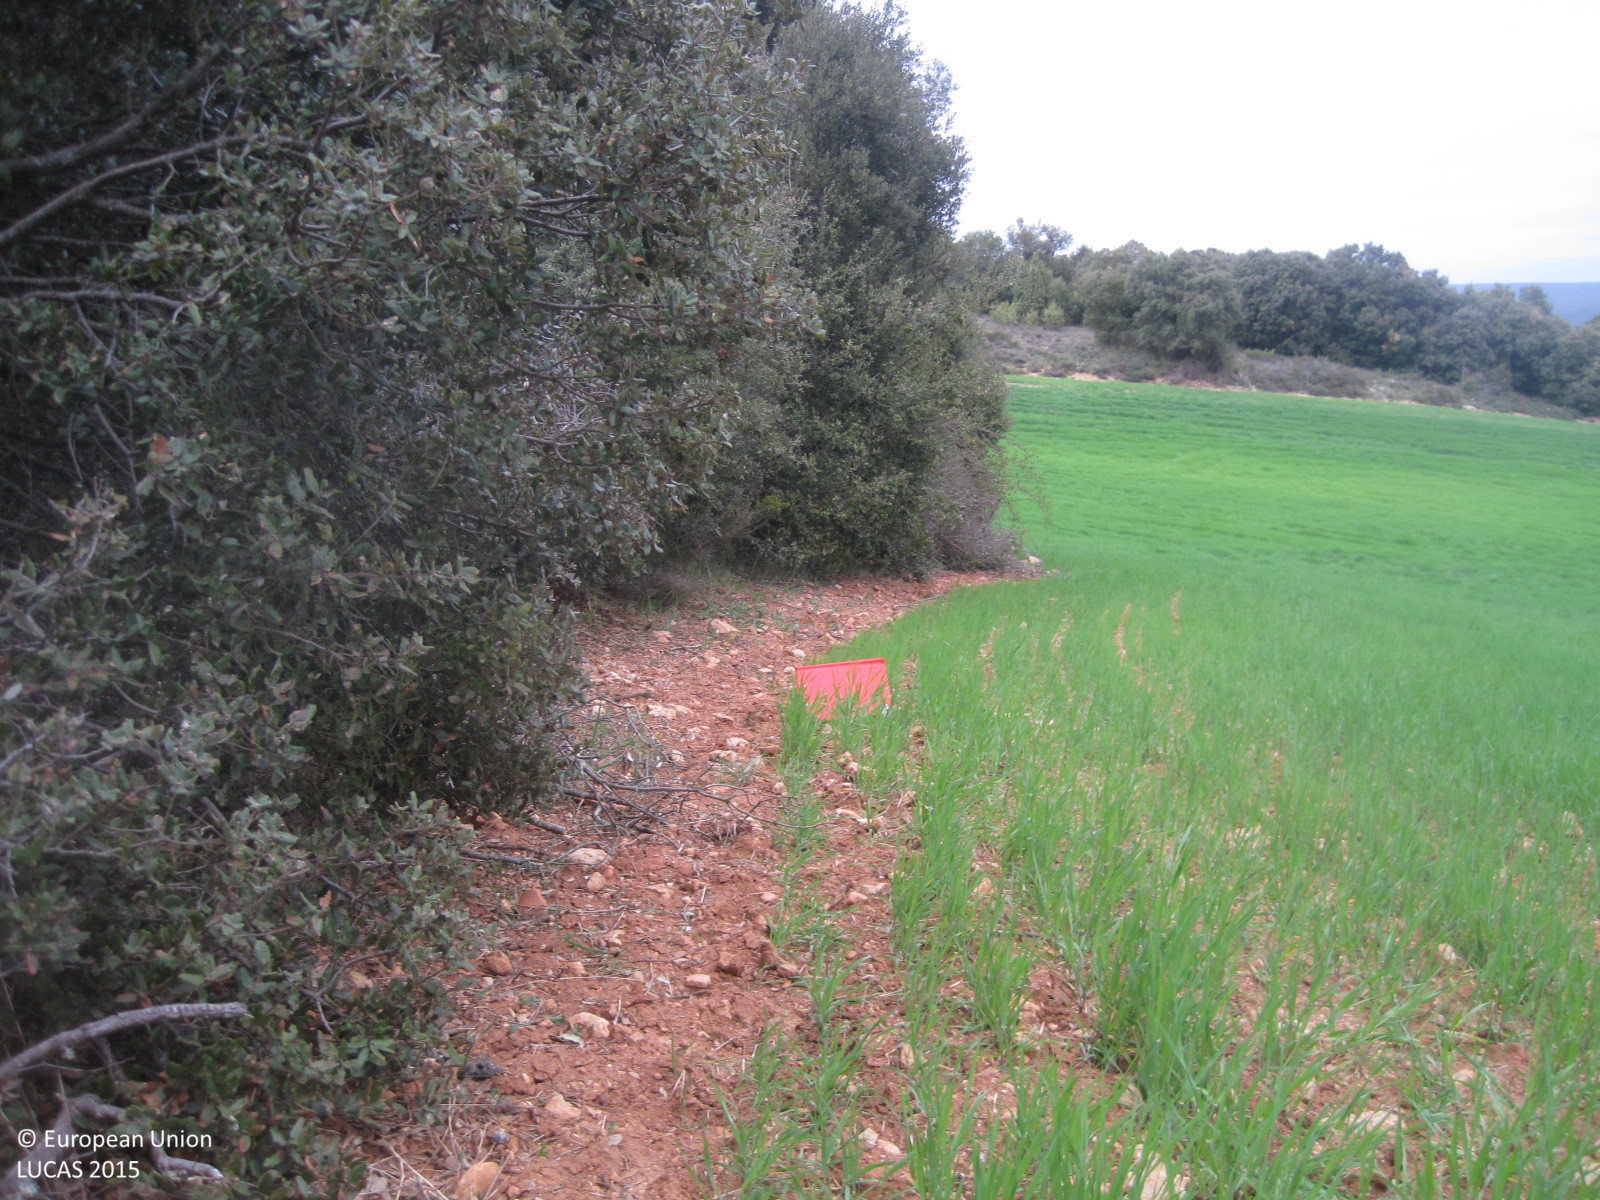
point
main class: Cropland
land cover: Barley
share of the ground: > 75 %
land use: Agriculture (excluding fallow land and kitchen gardens)
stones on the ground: > 50 %
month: April
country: ES
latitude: 42.6428
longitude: -2.2034
